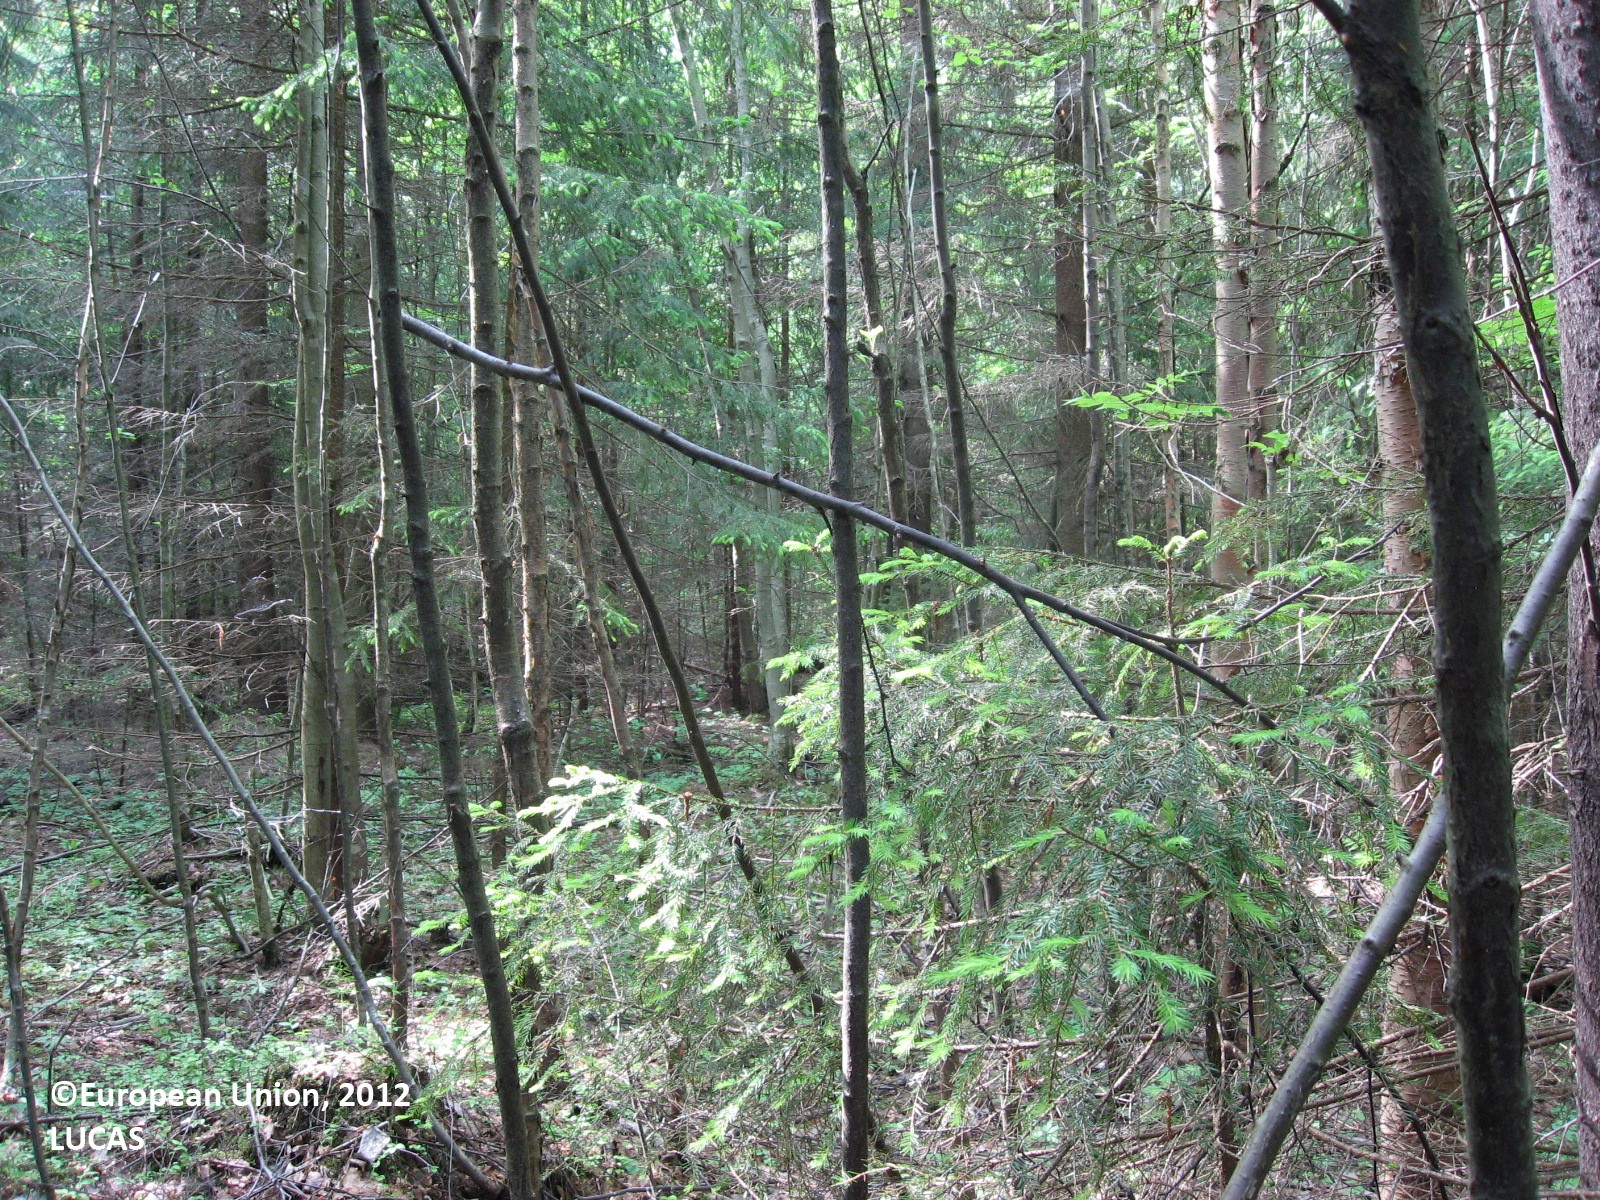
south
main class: Woodland
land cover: Spruce dominated coniferous woodland
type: boreal forest
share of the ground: > 75 %
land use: Forestry
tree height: > 5 m
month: June
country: FI
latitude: 60.3539
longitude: 24.9241
